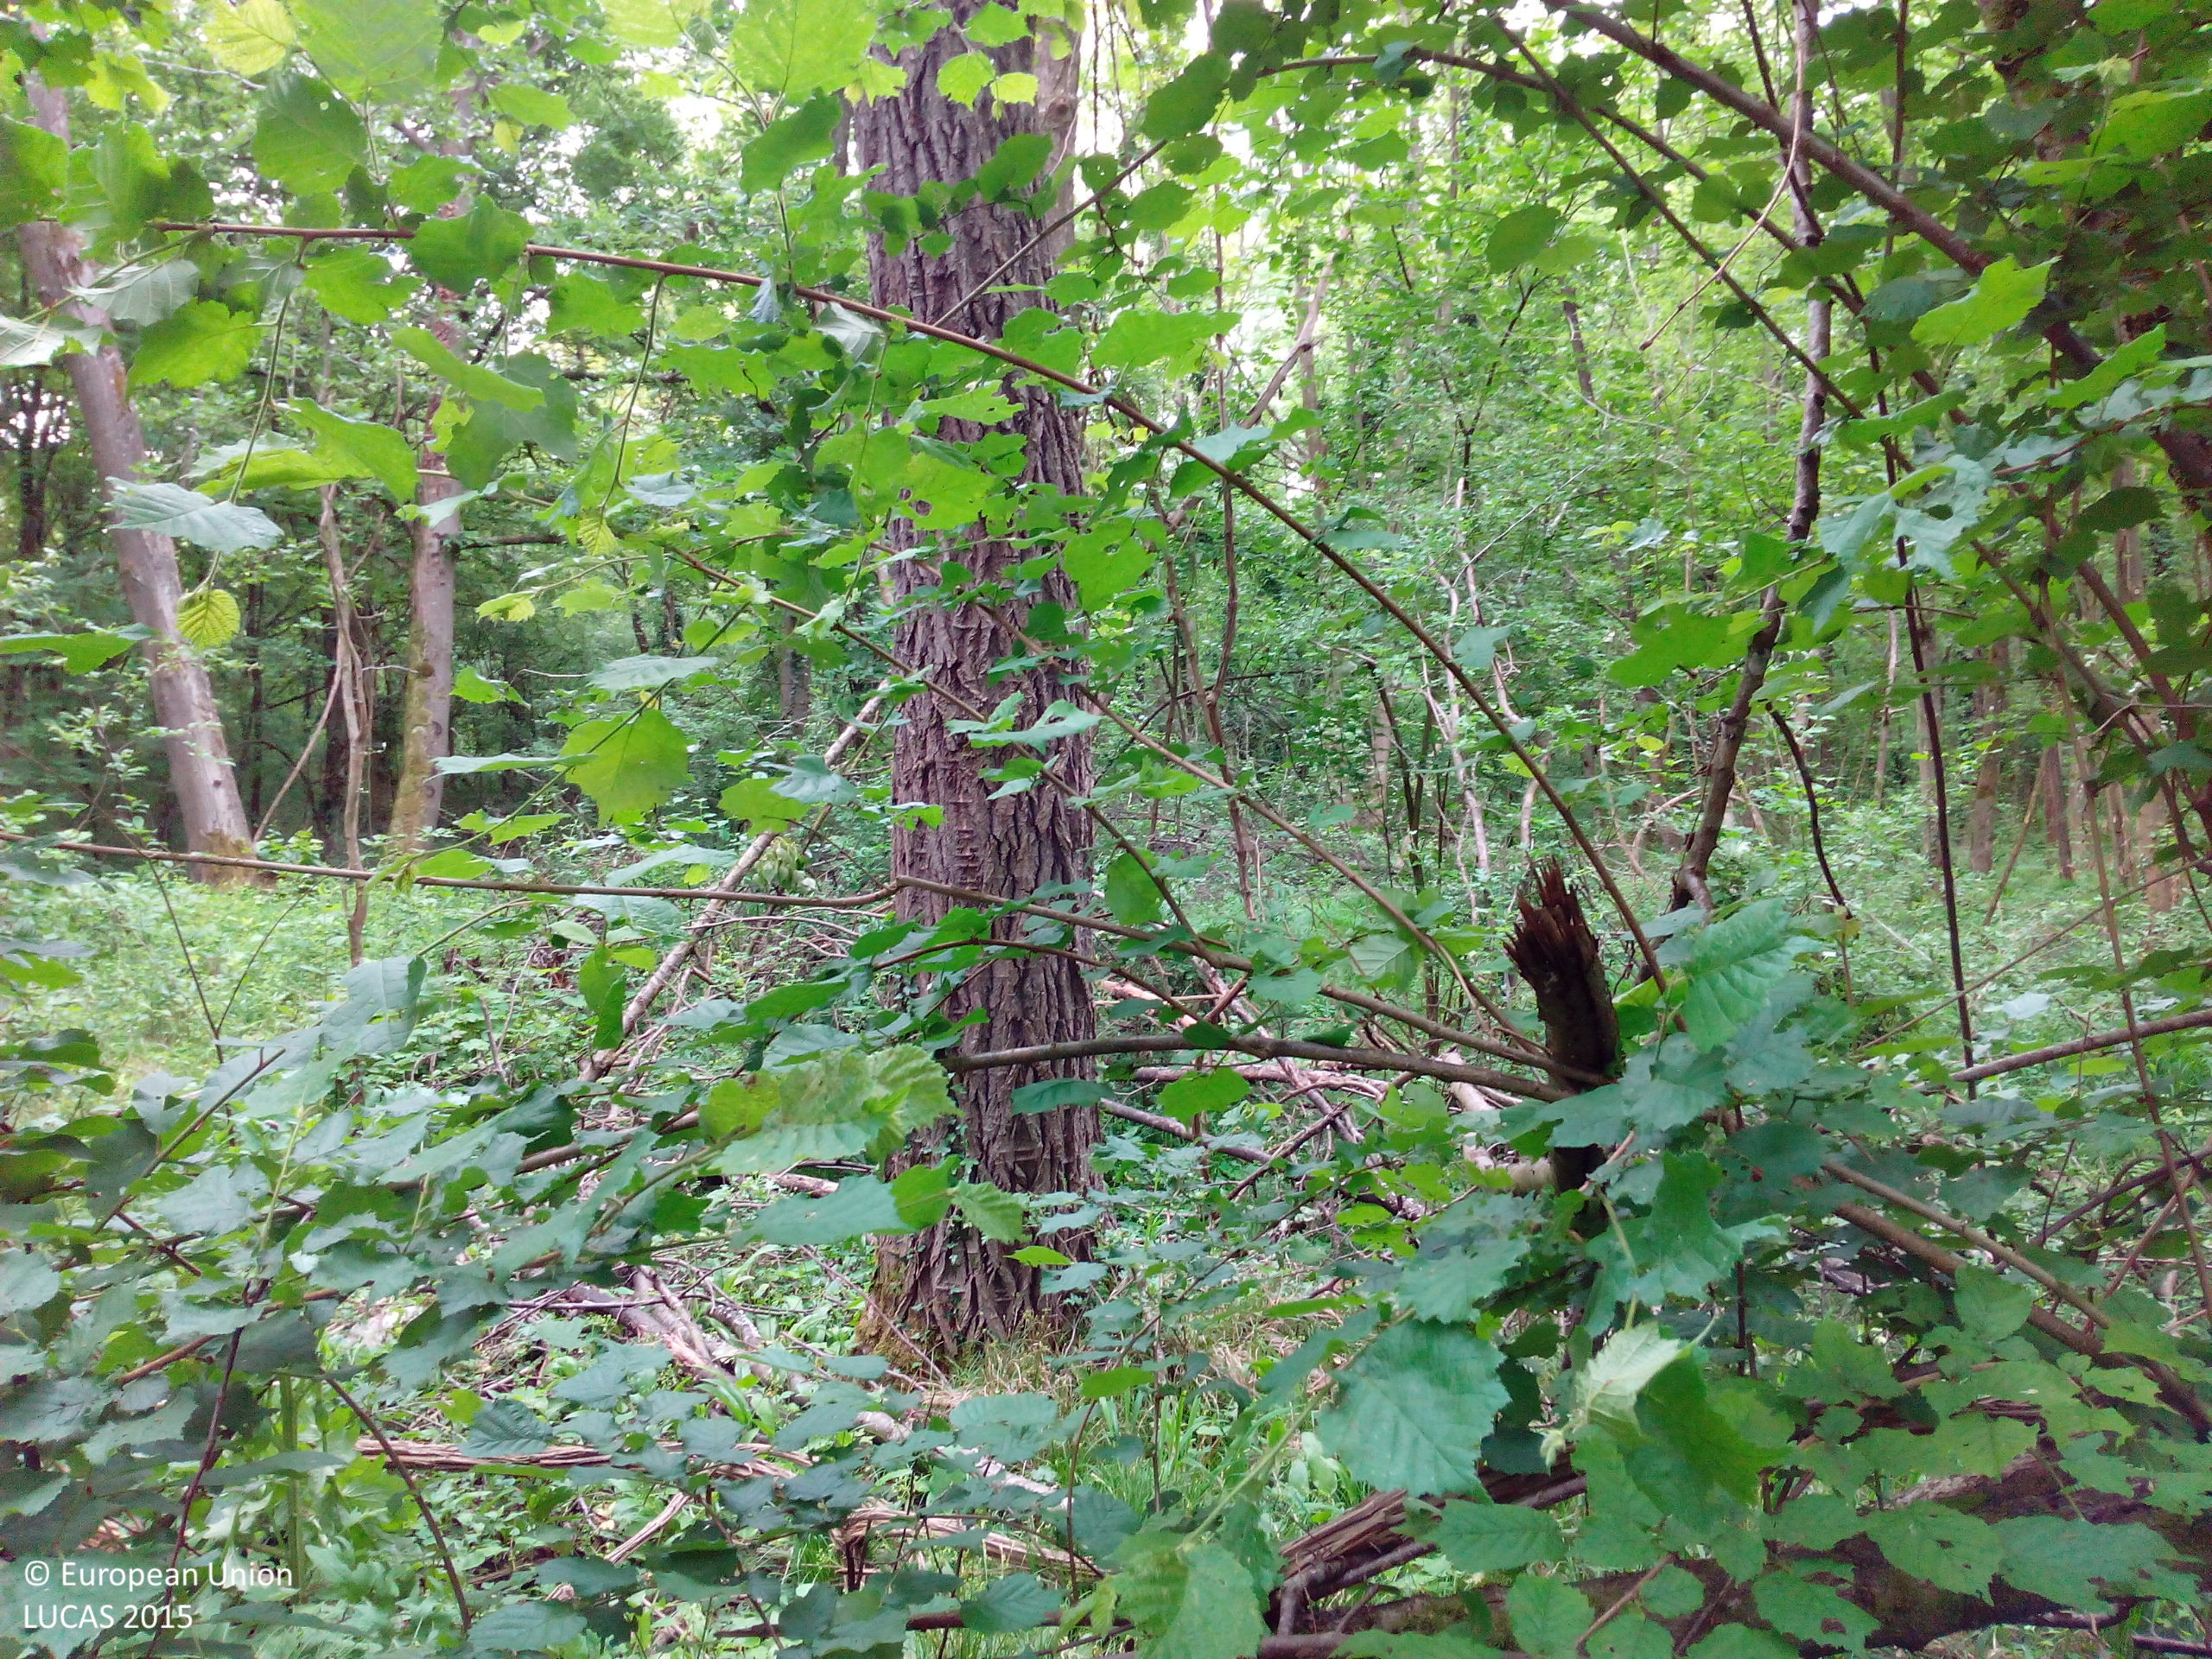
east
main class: Woodland
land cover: Broadleaved woodland
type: floodplain forest
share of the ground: > 75 %
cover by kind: broadleaved forest trees 85 %, shrubs 10 %, herbaceous plants 5 %
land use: Forestry
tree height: > 5 m
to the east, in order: Broadleaved woodland; Tracks; Broadleaved woodland; Grass margins; Common wheat
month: May
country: DE
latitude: 47.9641
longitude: 7.6306
